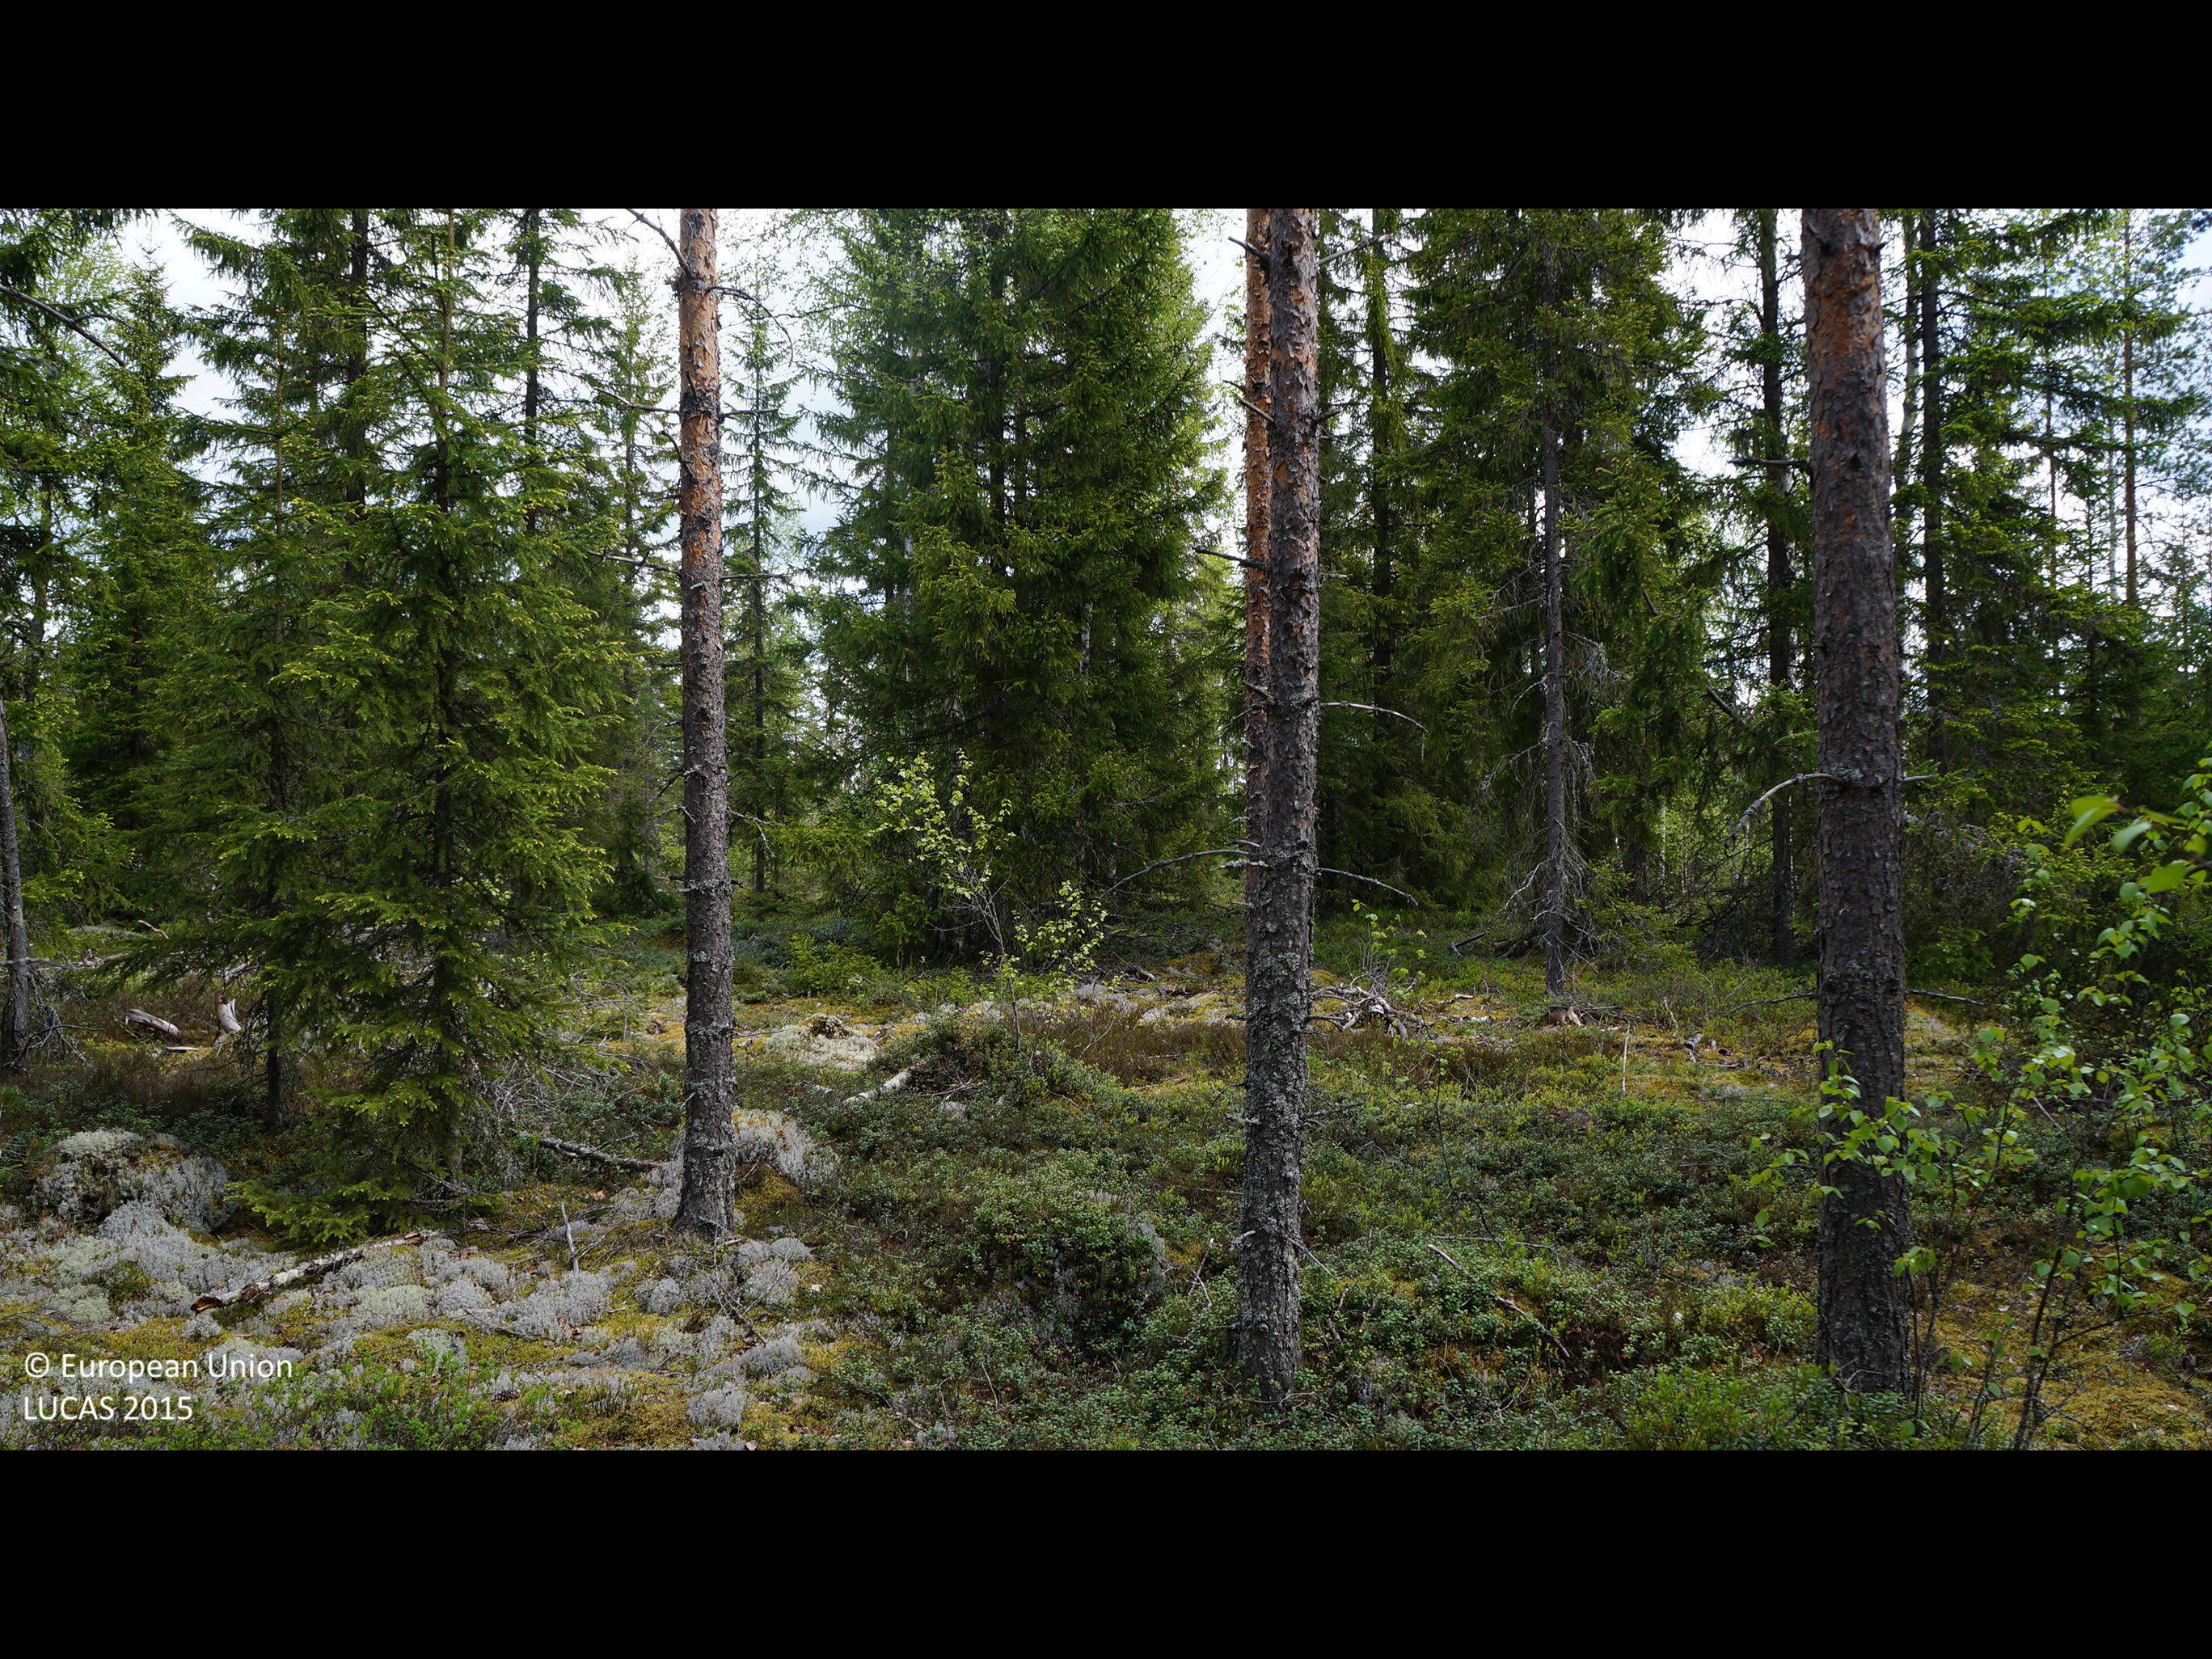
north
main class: Woodland
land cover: Pine dominated mixed woodland
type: boreal forest
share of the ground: 50 - 75 %
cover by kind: coniferous forest trees 40 %, shrubs 25 %, broadleaved forest trees 20 %, lichens and mosses 15 %
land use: Forestry
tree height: > 5 m
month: June
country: FI
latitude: 63.8045
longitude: 24.2649
